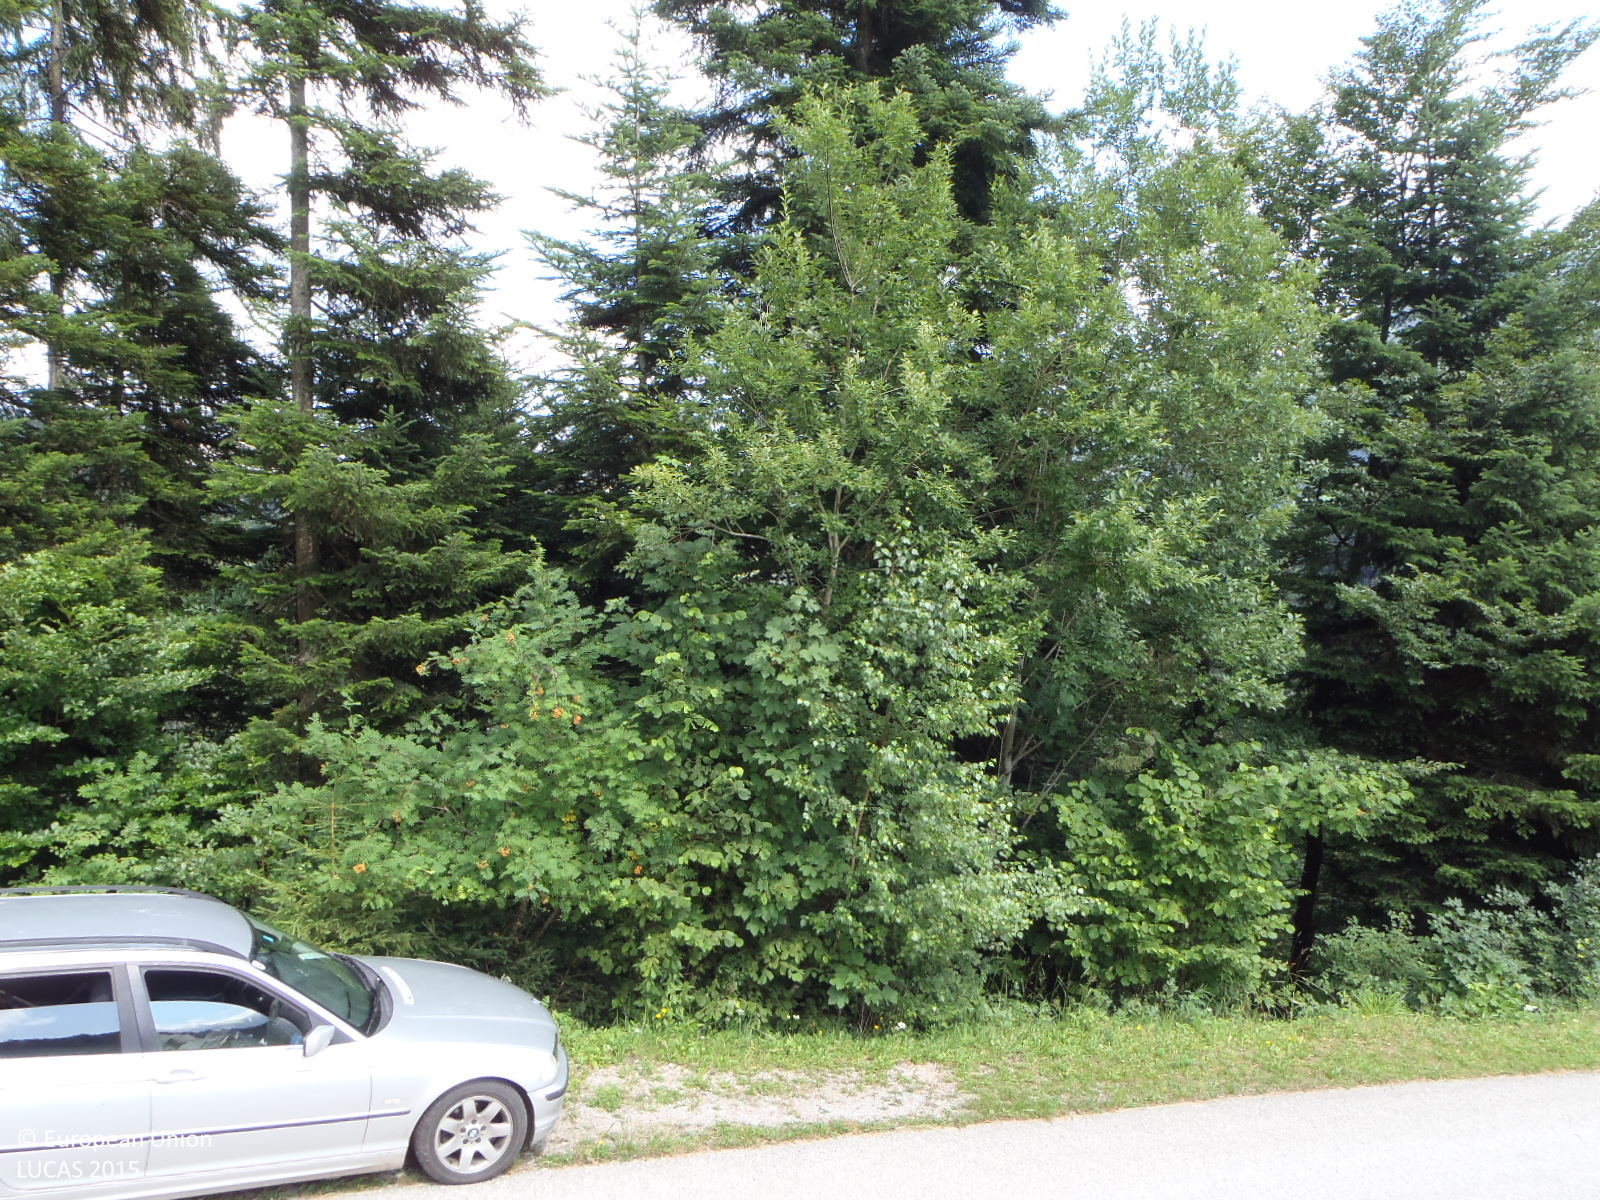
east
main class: Grassland
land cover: Grassland without tree/shrub cover
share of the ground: > 75 %
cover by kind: herbaceous plants 100 %
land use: Agriculture (excluding fallow land and kitchen gardens)
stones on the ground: < 10 %
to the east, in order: Grassland without tree/shrub cover; Dry stone walls; Paved roads, cycling and walking lanes; Grass margins; Other mixed woodland; Tracks; Other mixed woodland; Tracks; Other mixed woodland; Paved roads, cycling and walking lanes; Grassland without tree/shrub cover; Electric lines; Grassland without tree/shrub cover; Other mixed woodland
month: July
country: AT
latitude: 47.5177
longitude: 12.1896
